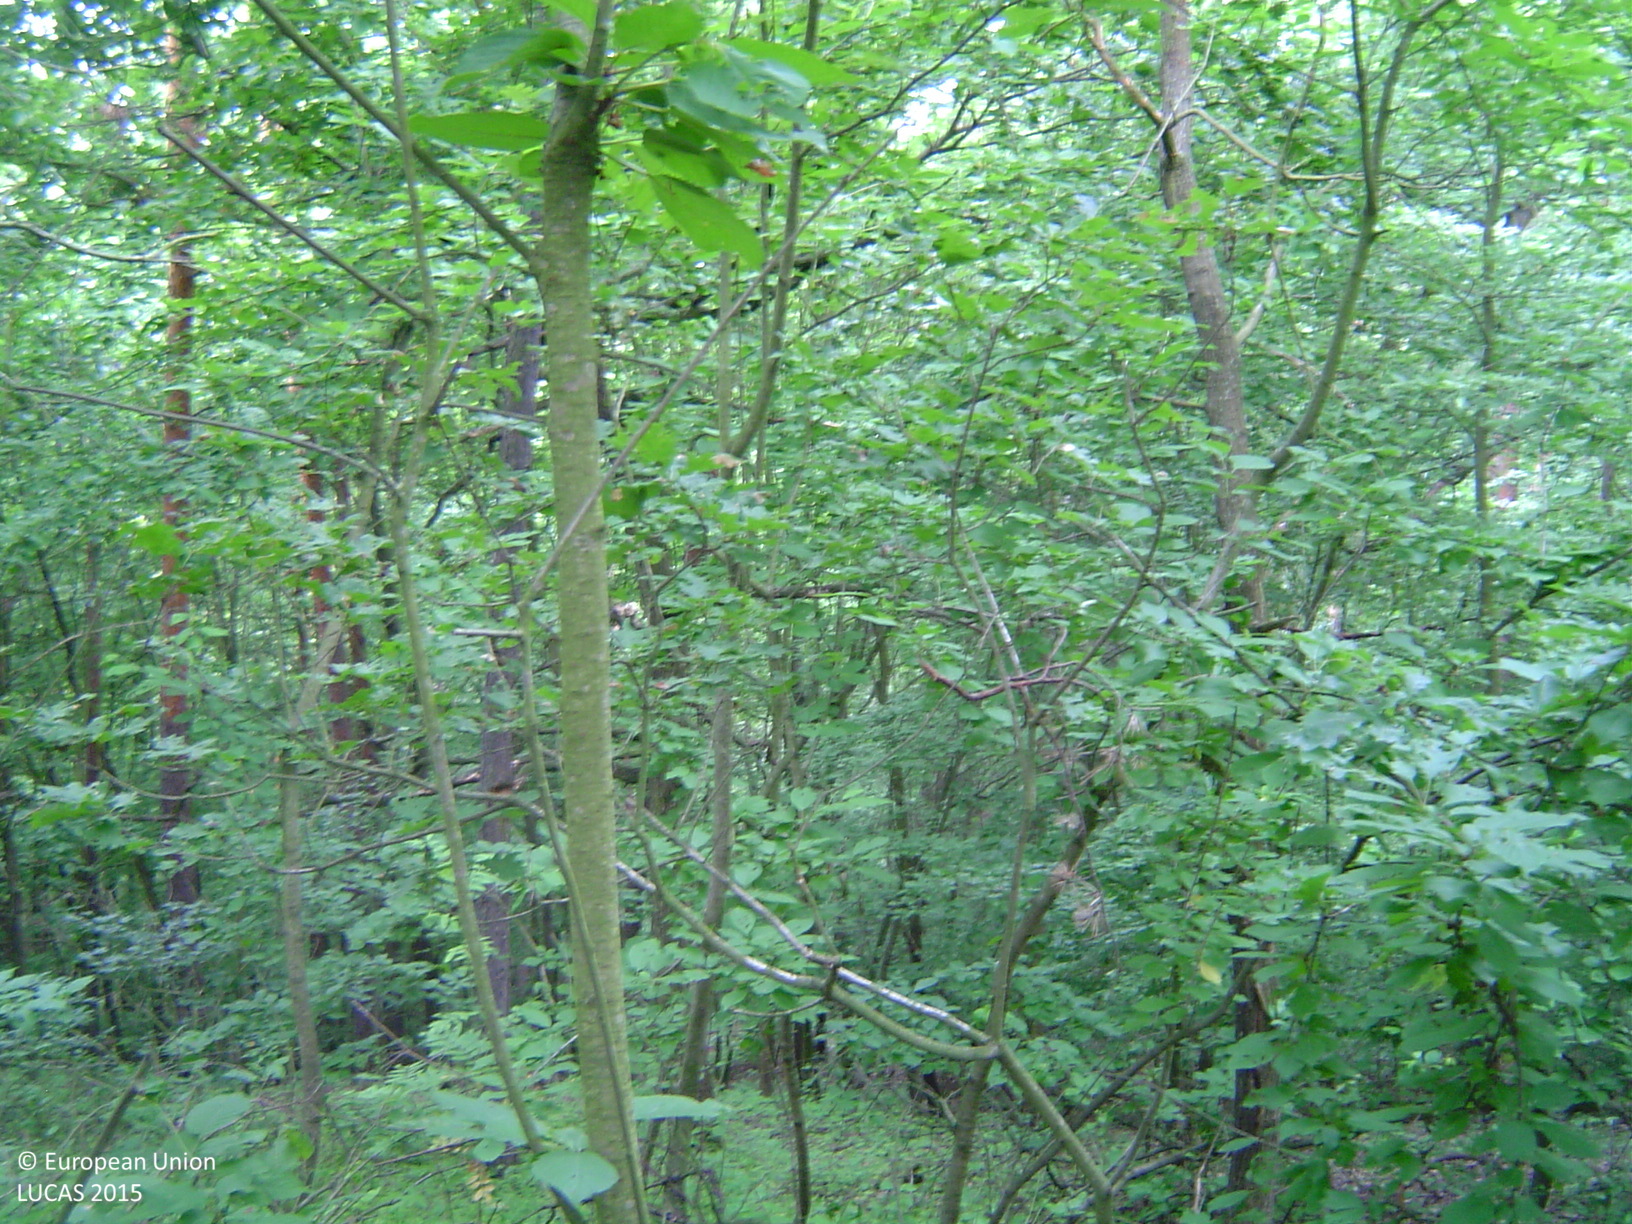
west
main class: Woodland
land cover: Pine dominated mixed woodland
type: hemiboreal forest and nemoral coniferous forest and mixed broadleaved-coniferous forest
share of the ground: > 75 %
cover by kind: coniferous forest trees 70 %, broadleaved forest trees 25 %, shrubs 5 %
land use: Forestry
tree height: > 5 m
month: June
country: CZ
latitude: 49.1294
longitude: 16.2414
